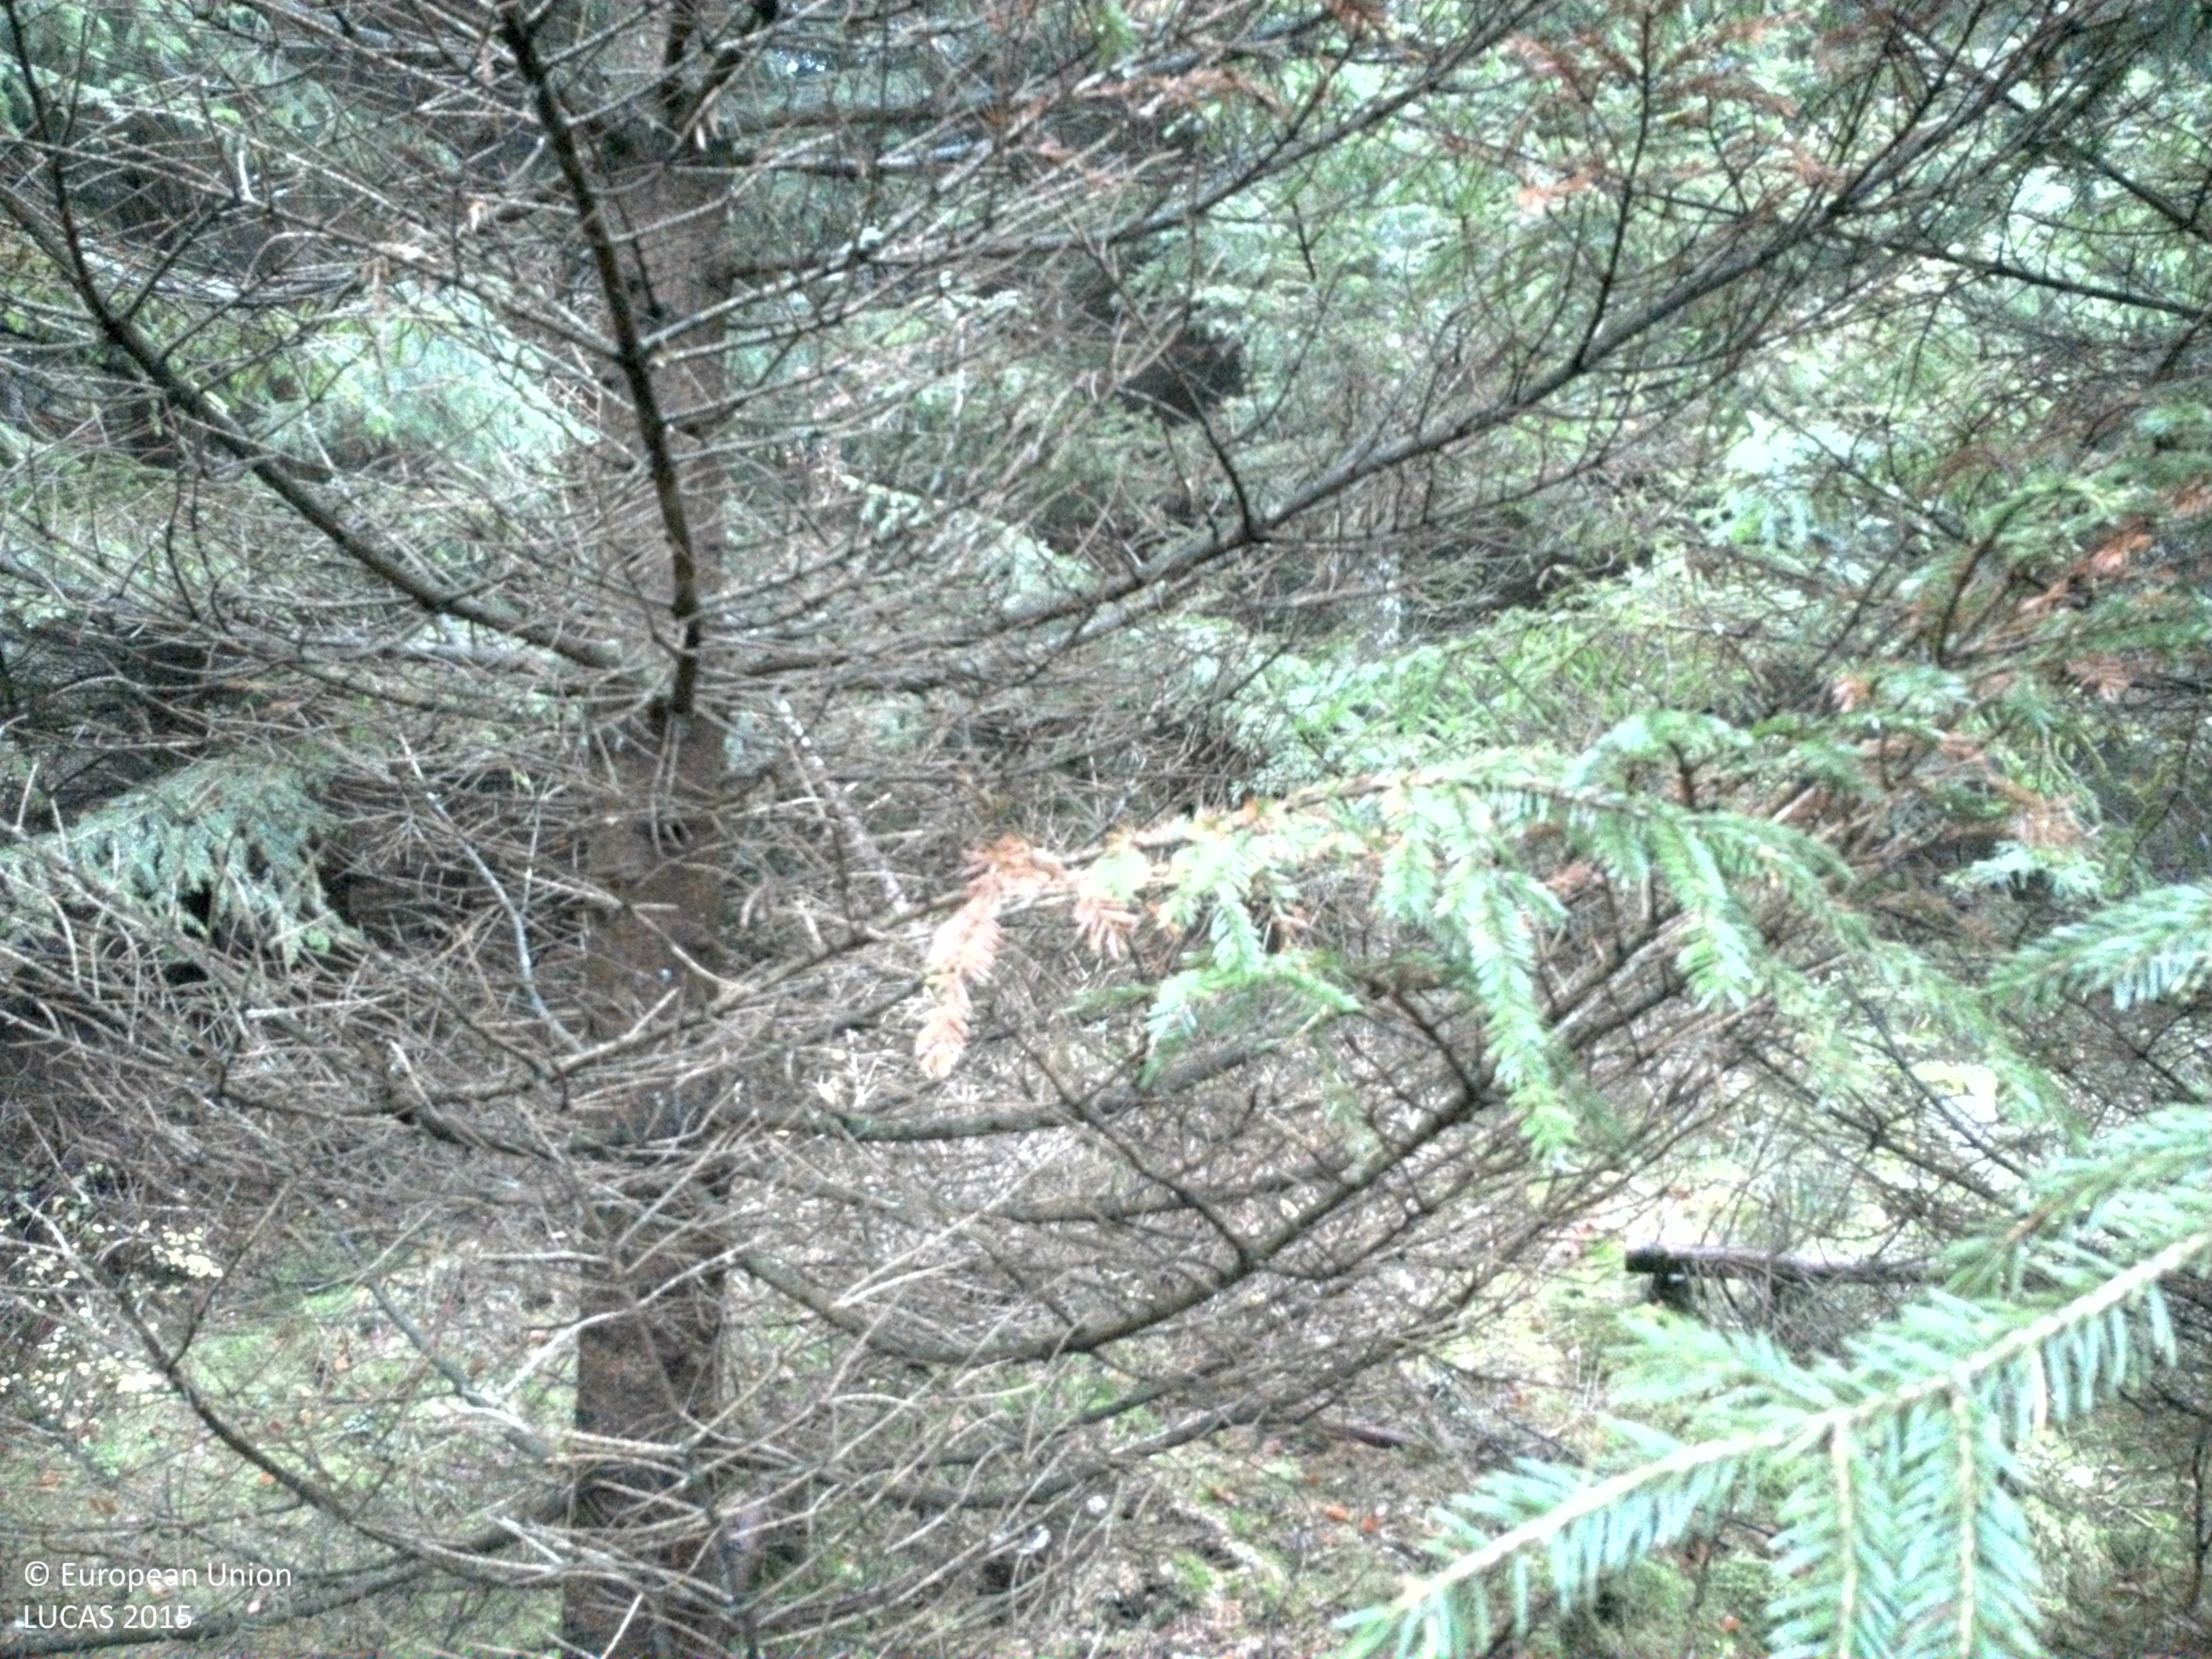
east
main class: Woodland
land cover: Spruce dominated coniferous woodland
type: hemiboreal forest and nemoral coniferous forest and mixed broadleaved-coniferous forest
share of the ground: > 75 %
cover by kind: coniferous forest trees 85 %, lichens and mosses 10 %, unconsolidated bare surface 5 %
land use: Forestry
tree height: > 5 m
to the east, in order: Spruce dominated coniferous woodland; Paved roads, cycling and walking lanes; Ditches and canals; Spruce dominated mixed woodland; Broadleaved woodland; Tracks; Dry stone walls; Spruce dominated coniferous woodland
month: November
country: SE
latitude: 56.2026
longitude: 13.1729
